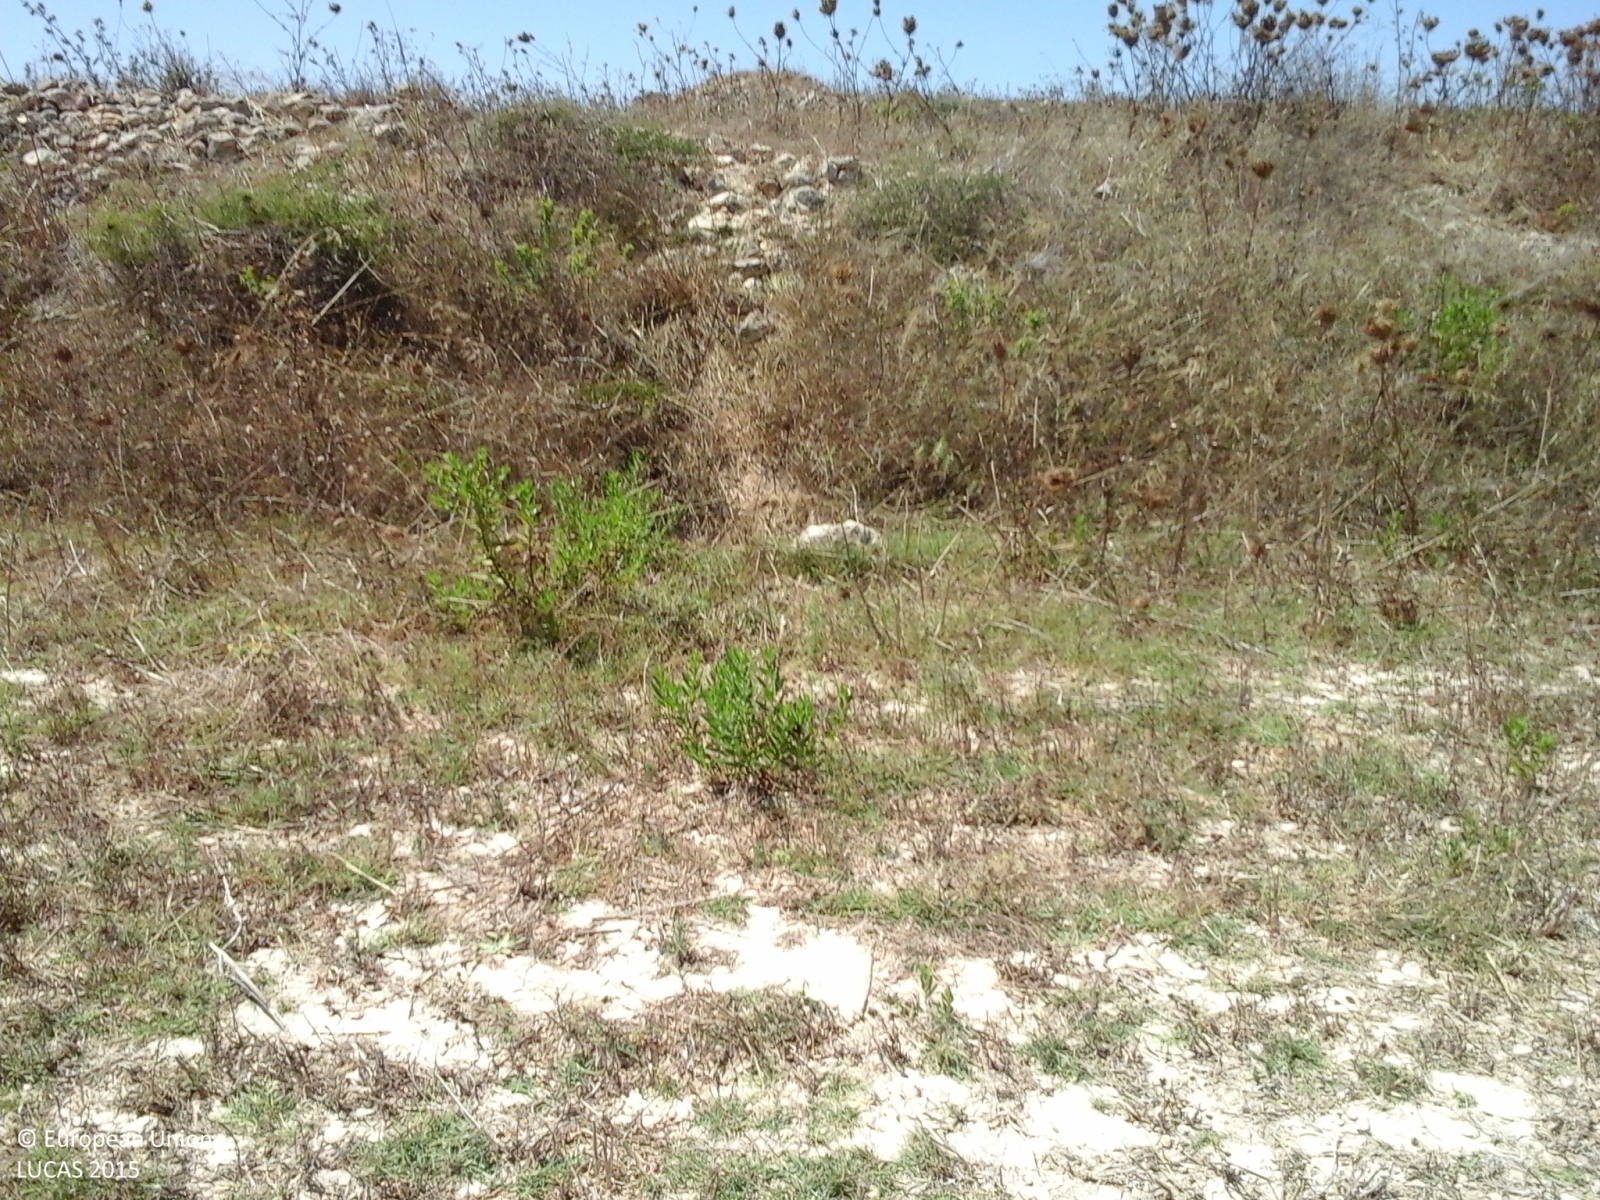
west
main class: Cropland
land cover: Mixed cereals for fodder
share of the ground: > 75 %
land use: Agriculture (excluding fallow land and kitchen gardens)
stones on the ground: < 10 %
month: July
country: IT
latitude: 39.9654
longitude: 8.4514
